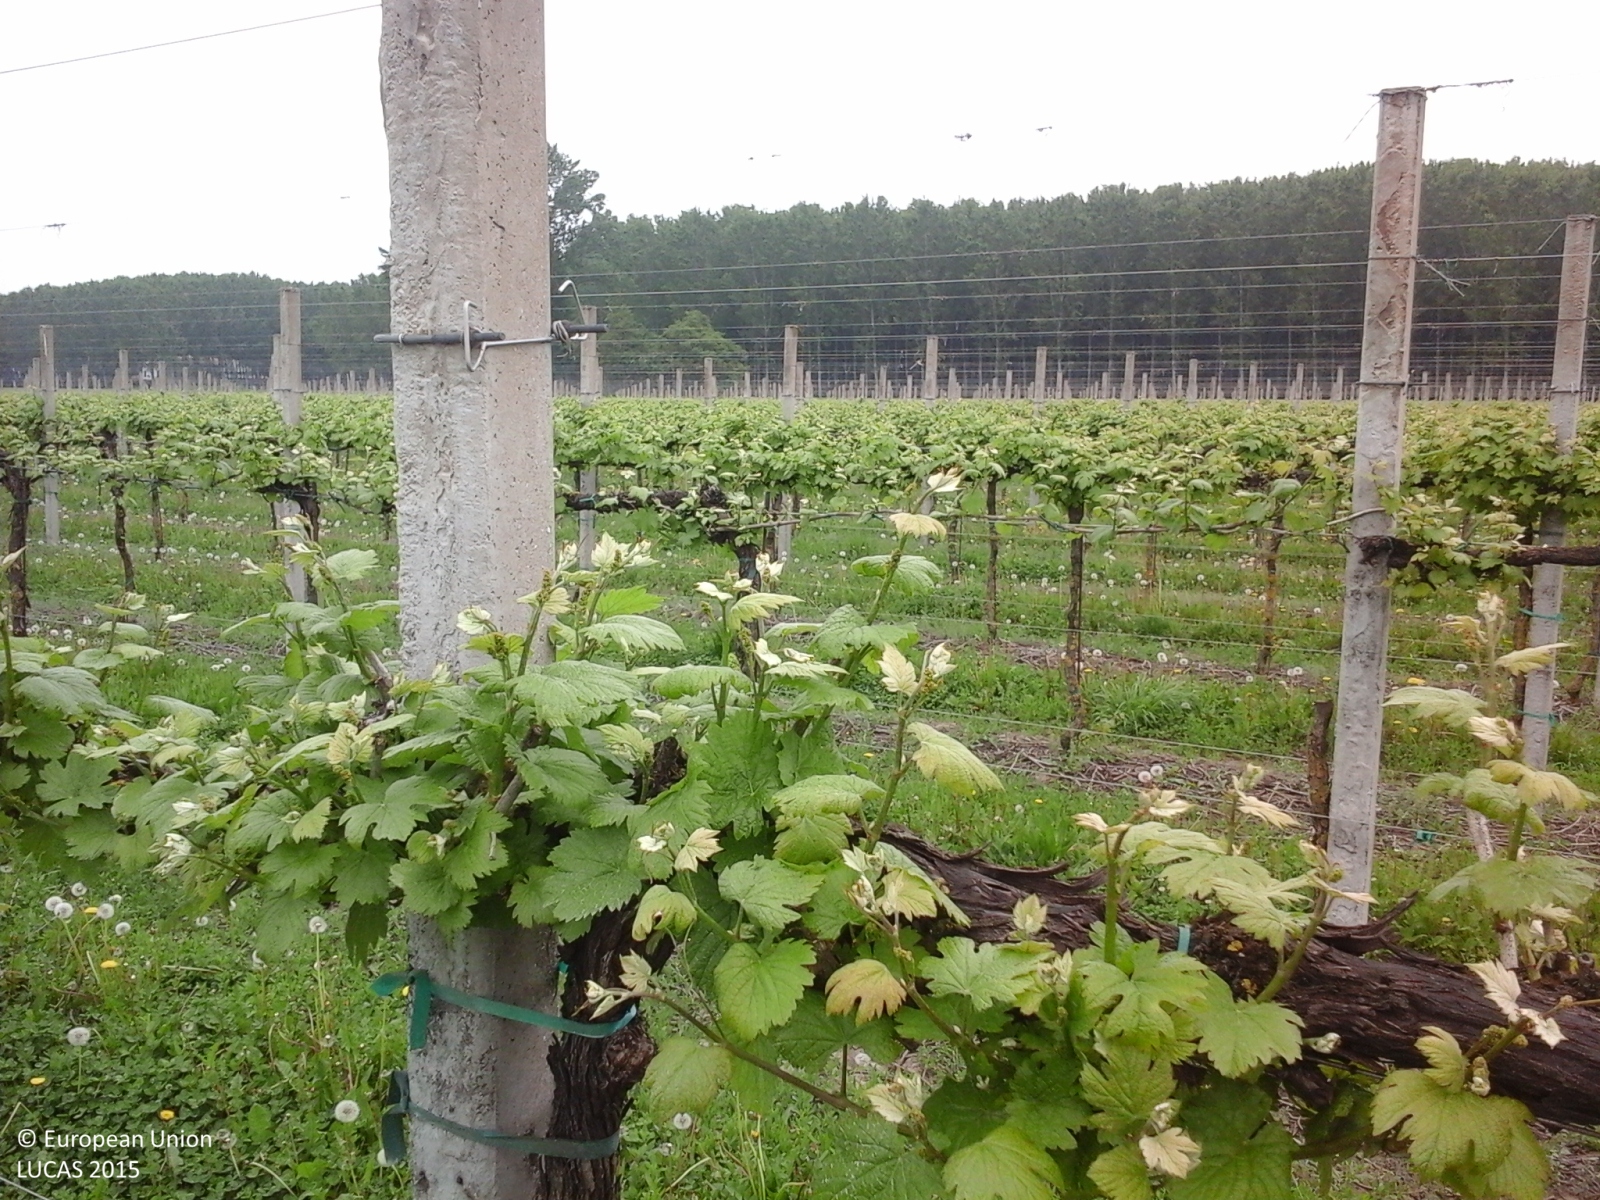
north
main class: Cropland
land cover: Vineyards
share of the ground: 10 - 25 %
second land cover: Grassland without tree/shrub cover
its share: > 75 %
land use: Agriculture (excluding fallow land and kitchen gardens)
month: May
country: IT
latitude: 44.9618
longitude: 10.6200
